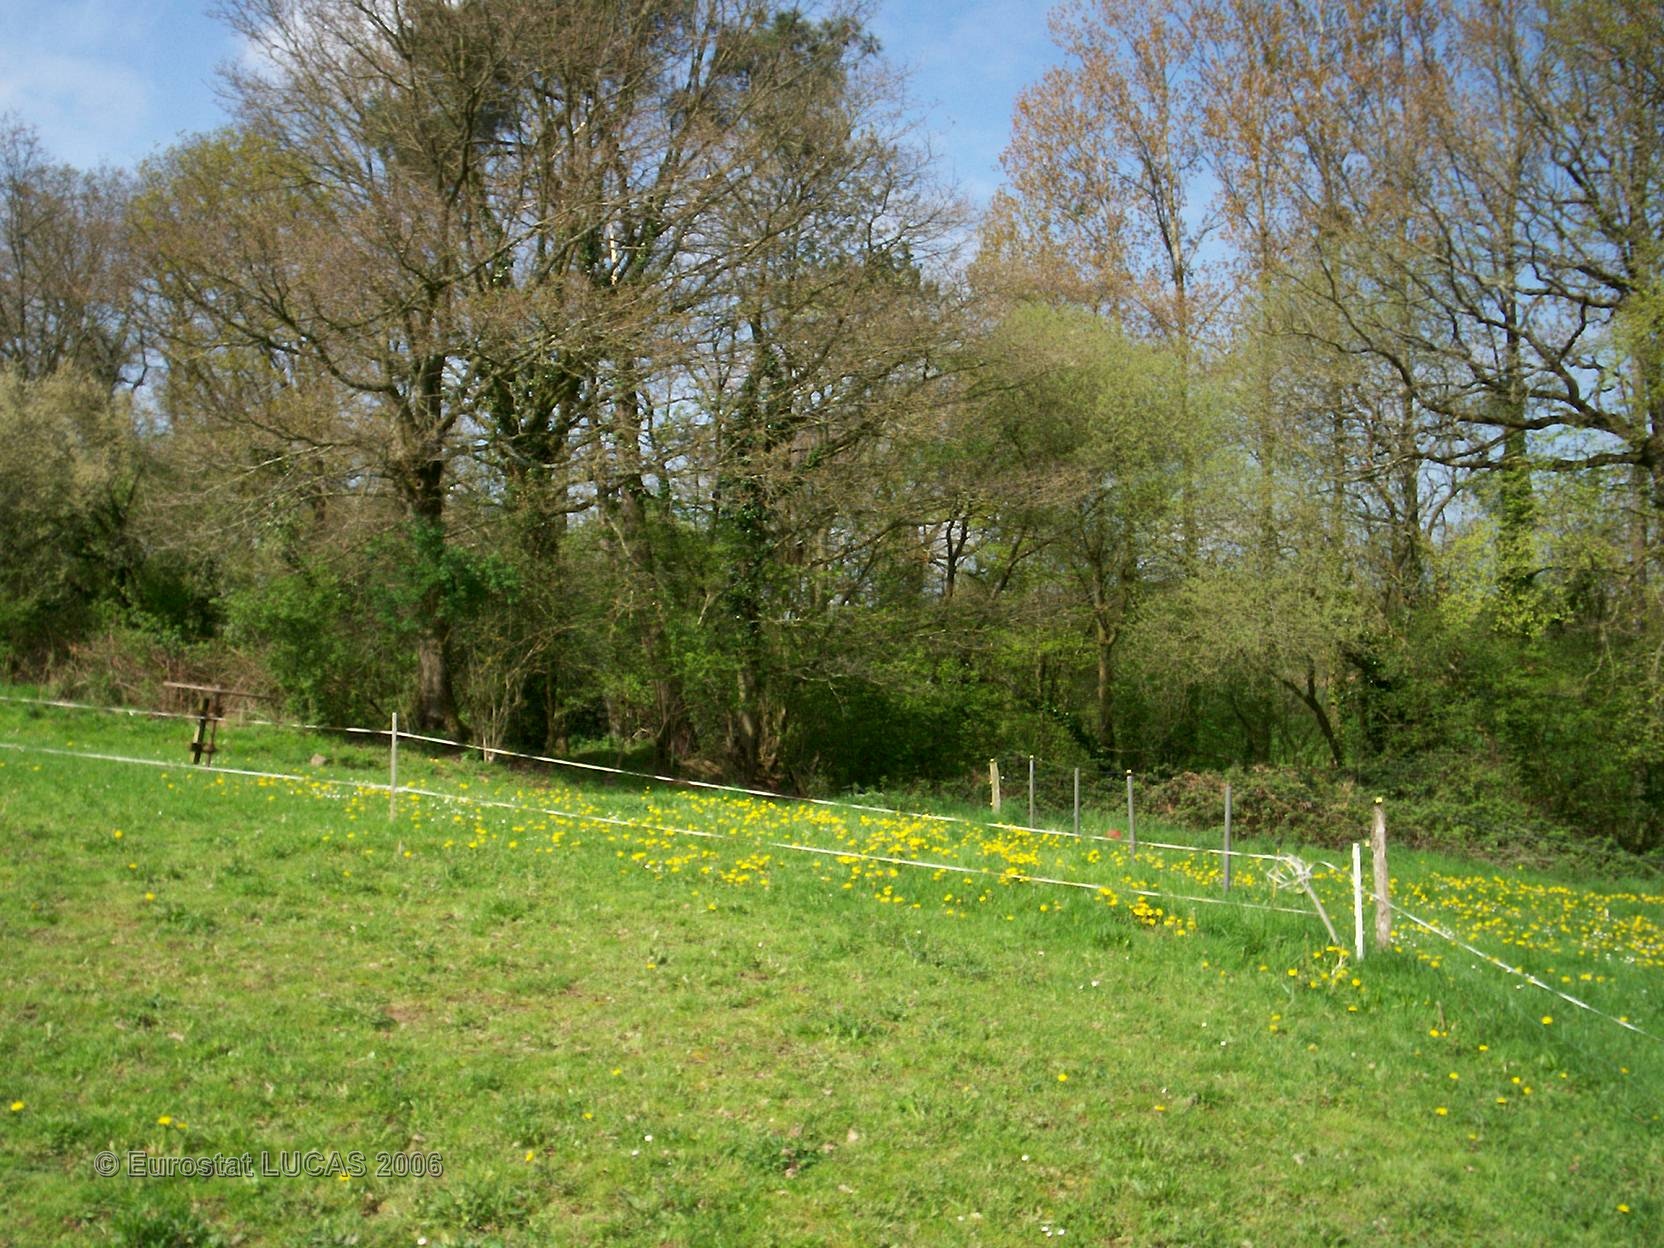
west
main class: Grassland
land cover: Grassland without tree/shrub cover
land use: Agriculture (excluding fallow land and kitchen gardens)
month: April
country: FR
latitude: 48.0497
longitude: -2.3868
